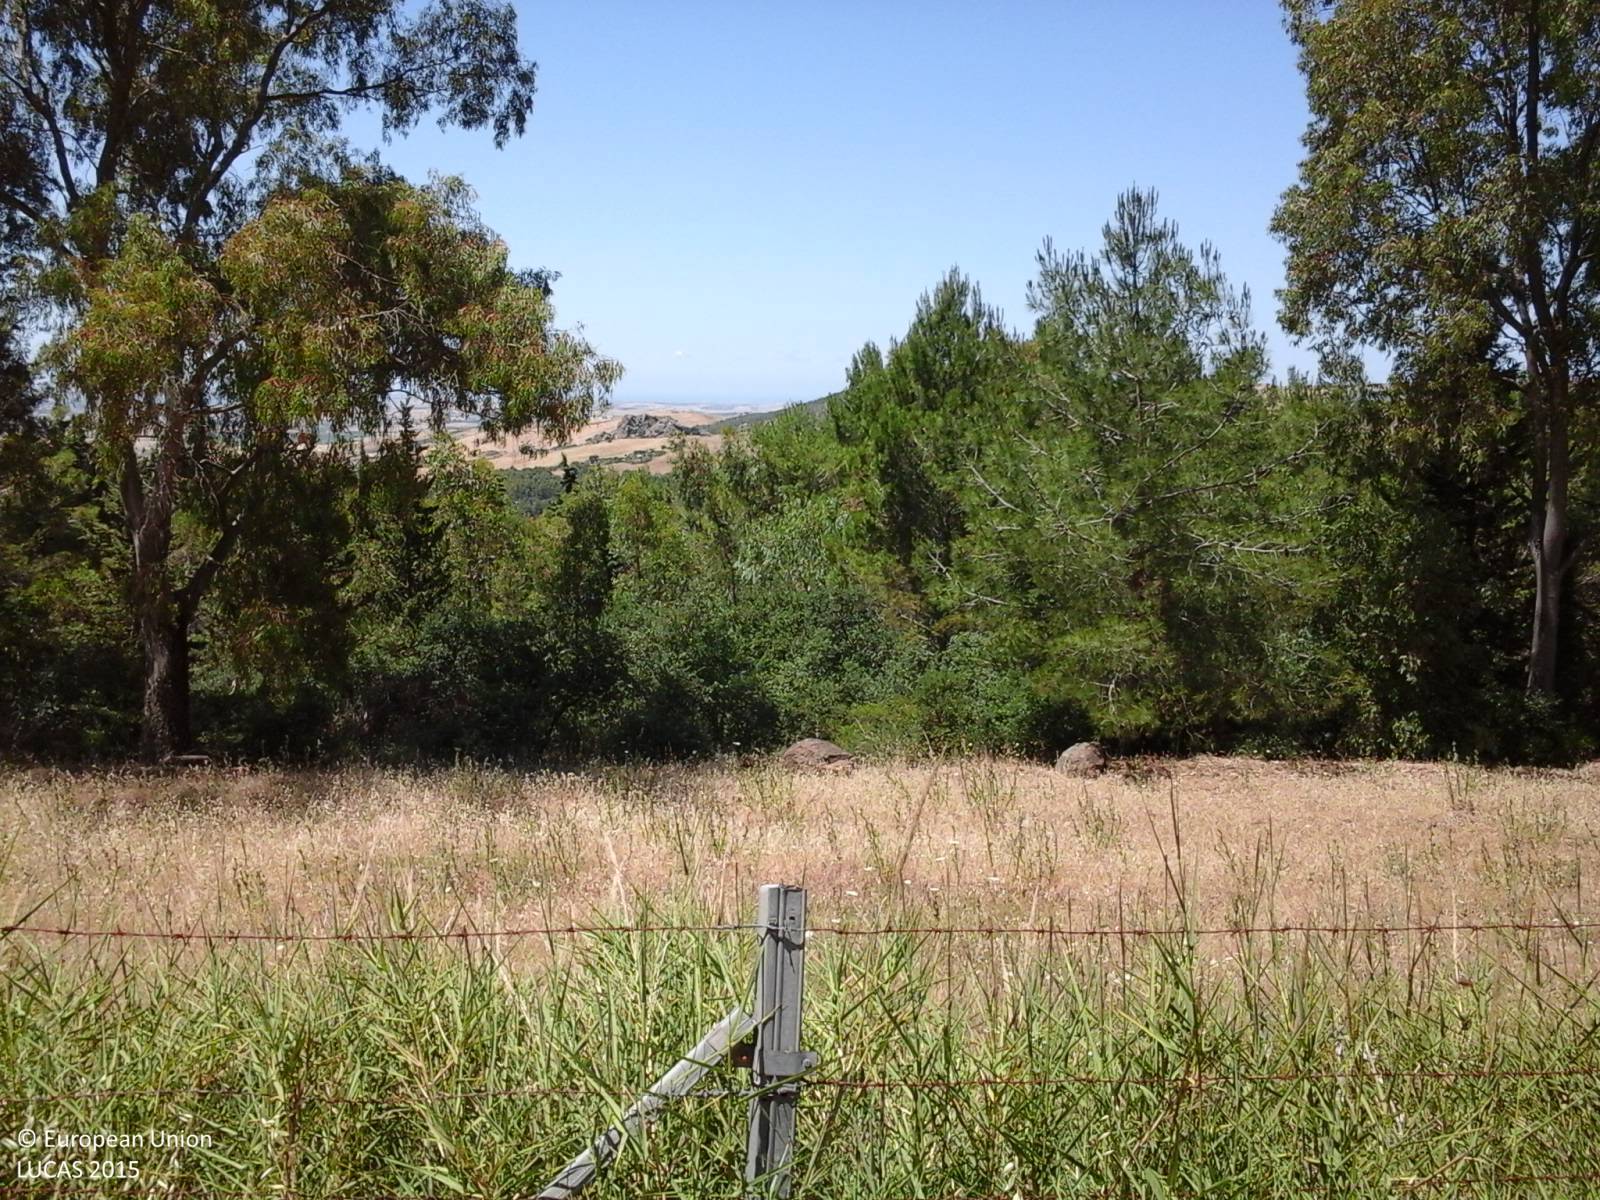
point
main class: Woodland
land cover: Other mixed woodland
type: coniferous forest of the mediterranean region
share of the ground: 50 - 75 %
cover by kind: coniferous forest trees 45 %, broadleaved forest trees 25 %, shrubs 15 %, herbaceous plants 15 %
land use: Forestry
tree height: > 5 m
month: June
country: IT
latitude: 37.9796
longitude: 12.7692
